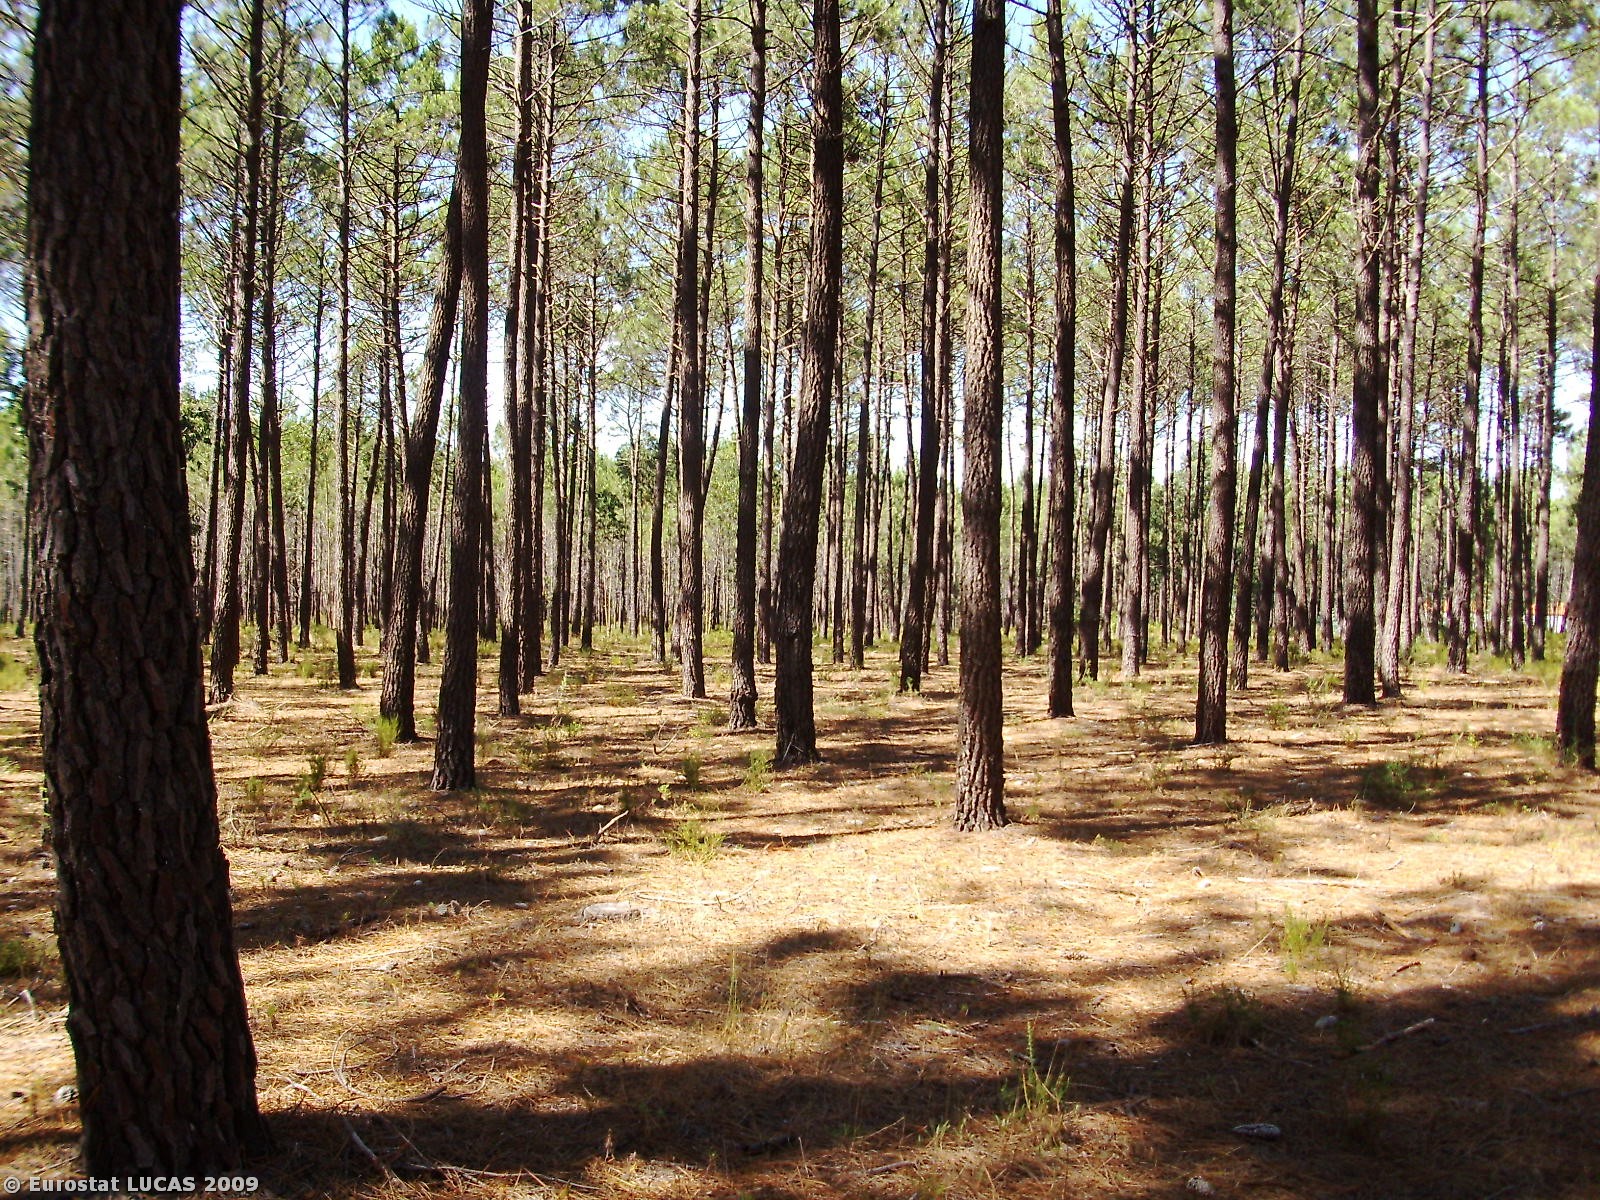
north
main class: Woodland
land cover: Coniferous woodland
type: coniferous forest of the mediterranean region
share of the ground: > 75 %
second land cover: Shrubland with sparse tree cover
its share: 10 - 25 %
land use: Forestry
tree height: > 5 m
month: July
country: PT
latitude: 39.7160
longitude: -8.9520
